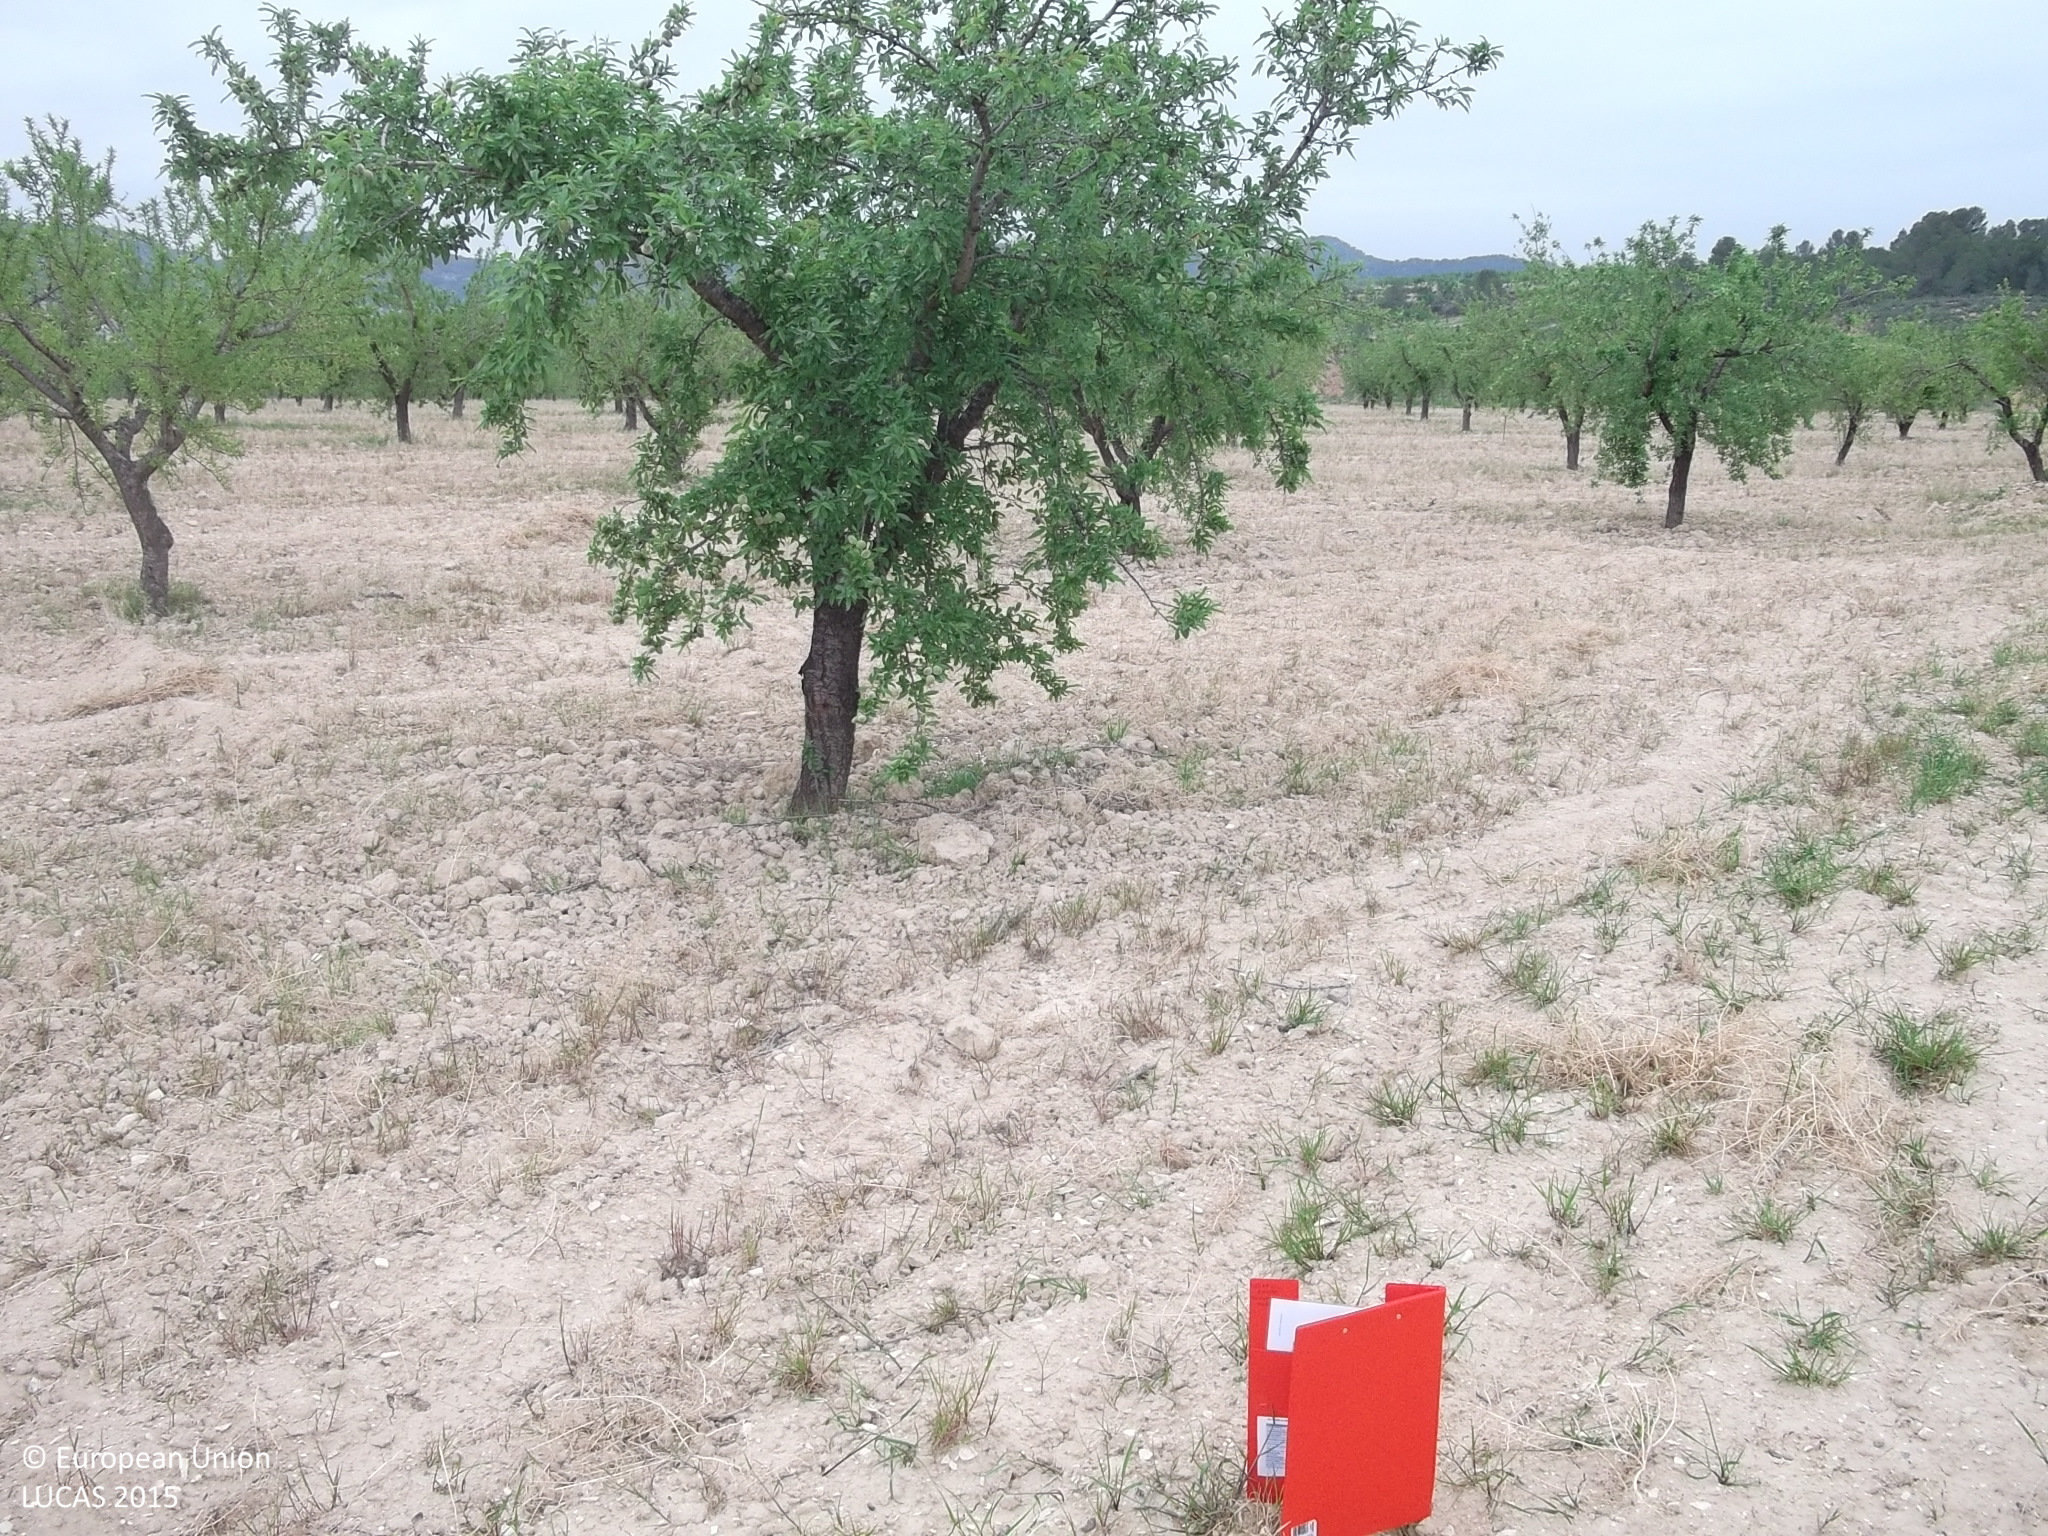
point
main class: Cropland
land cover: Nuts trees
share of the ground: 10 - 25 %
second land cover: Spontaneously vegetated surfaces
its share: > 75 %
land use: Agriculture (excluding fallow land and kitchen gardens)
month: April
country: ES
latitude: 37.9935
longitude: -1.5437
